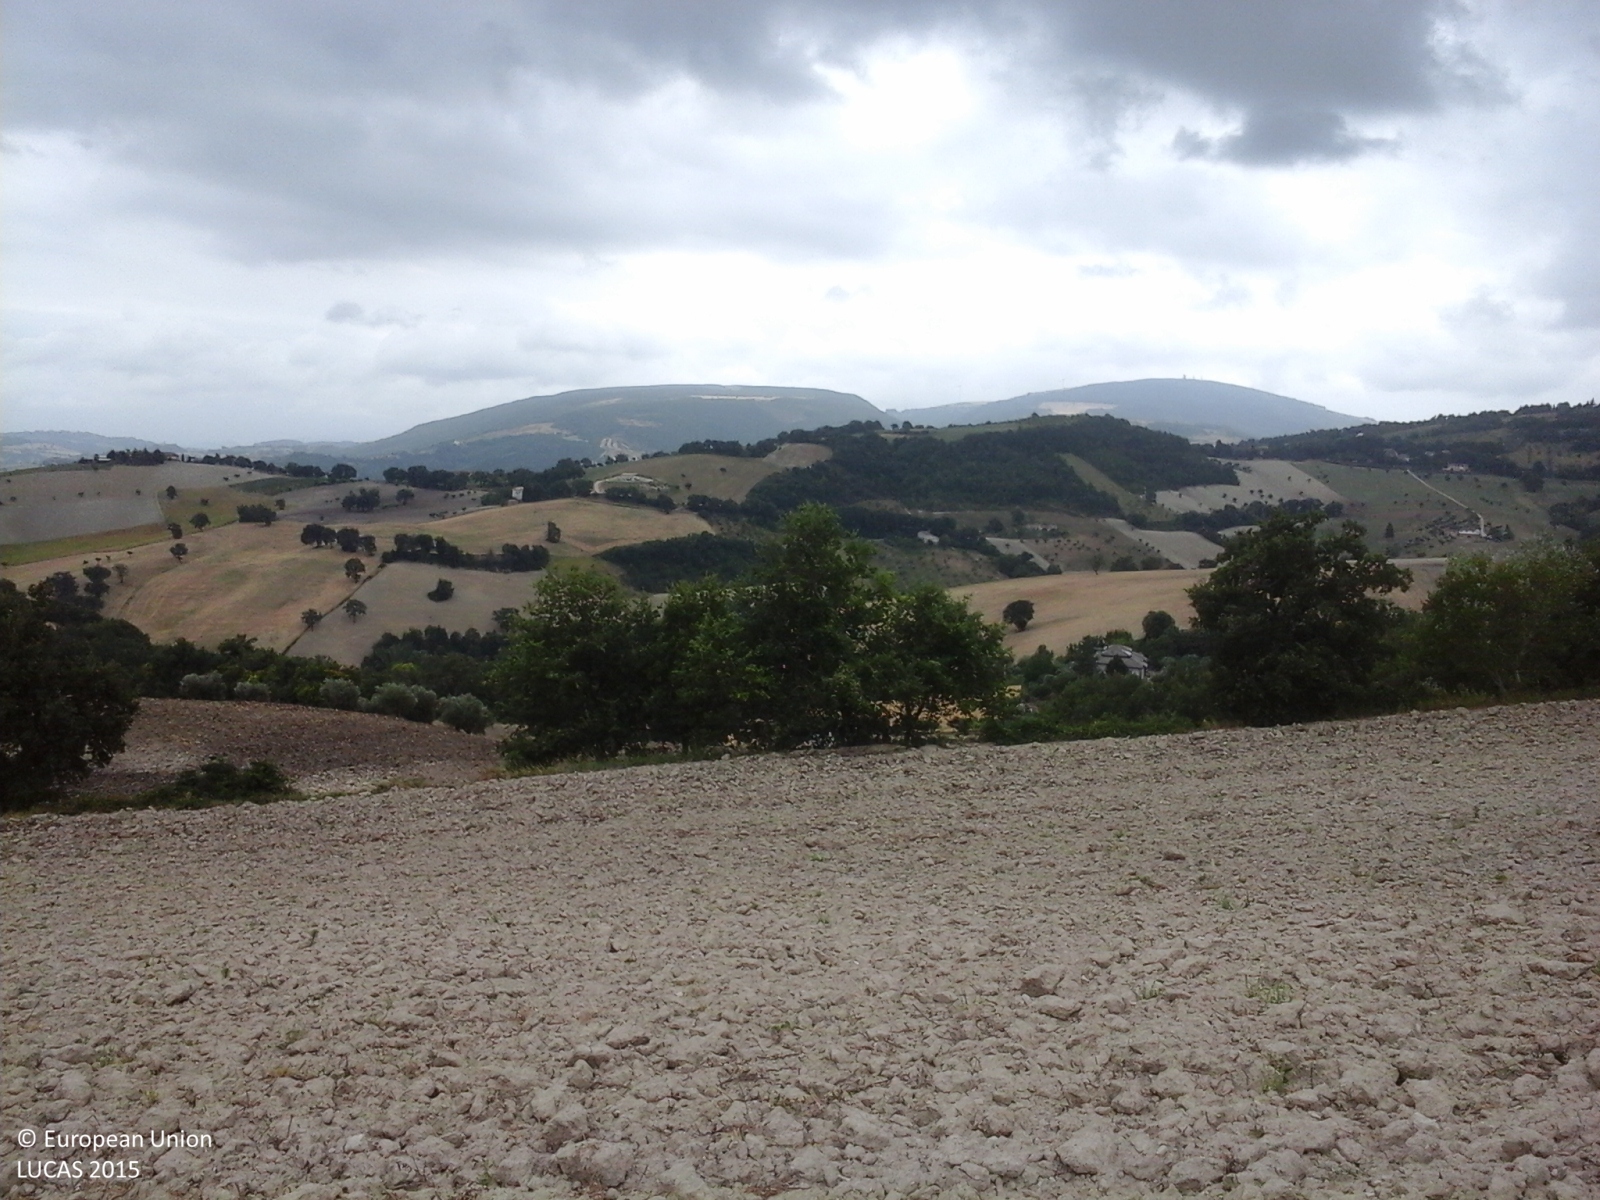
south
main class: Cropland
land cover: Dry pulses
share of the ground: > 75 %
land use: Agriculture (excluding fallow land and kitchen gardens)
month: July
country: IT
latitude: 43.2553
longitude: 13.1573
